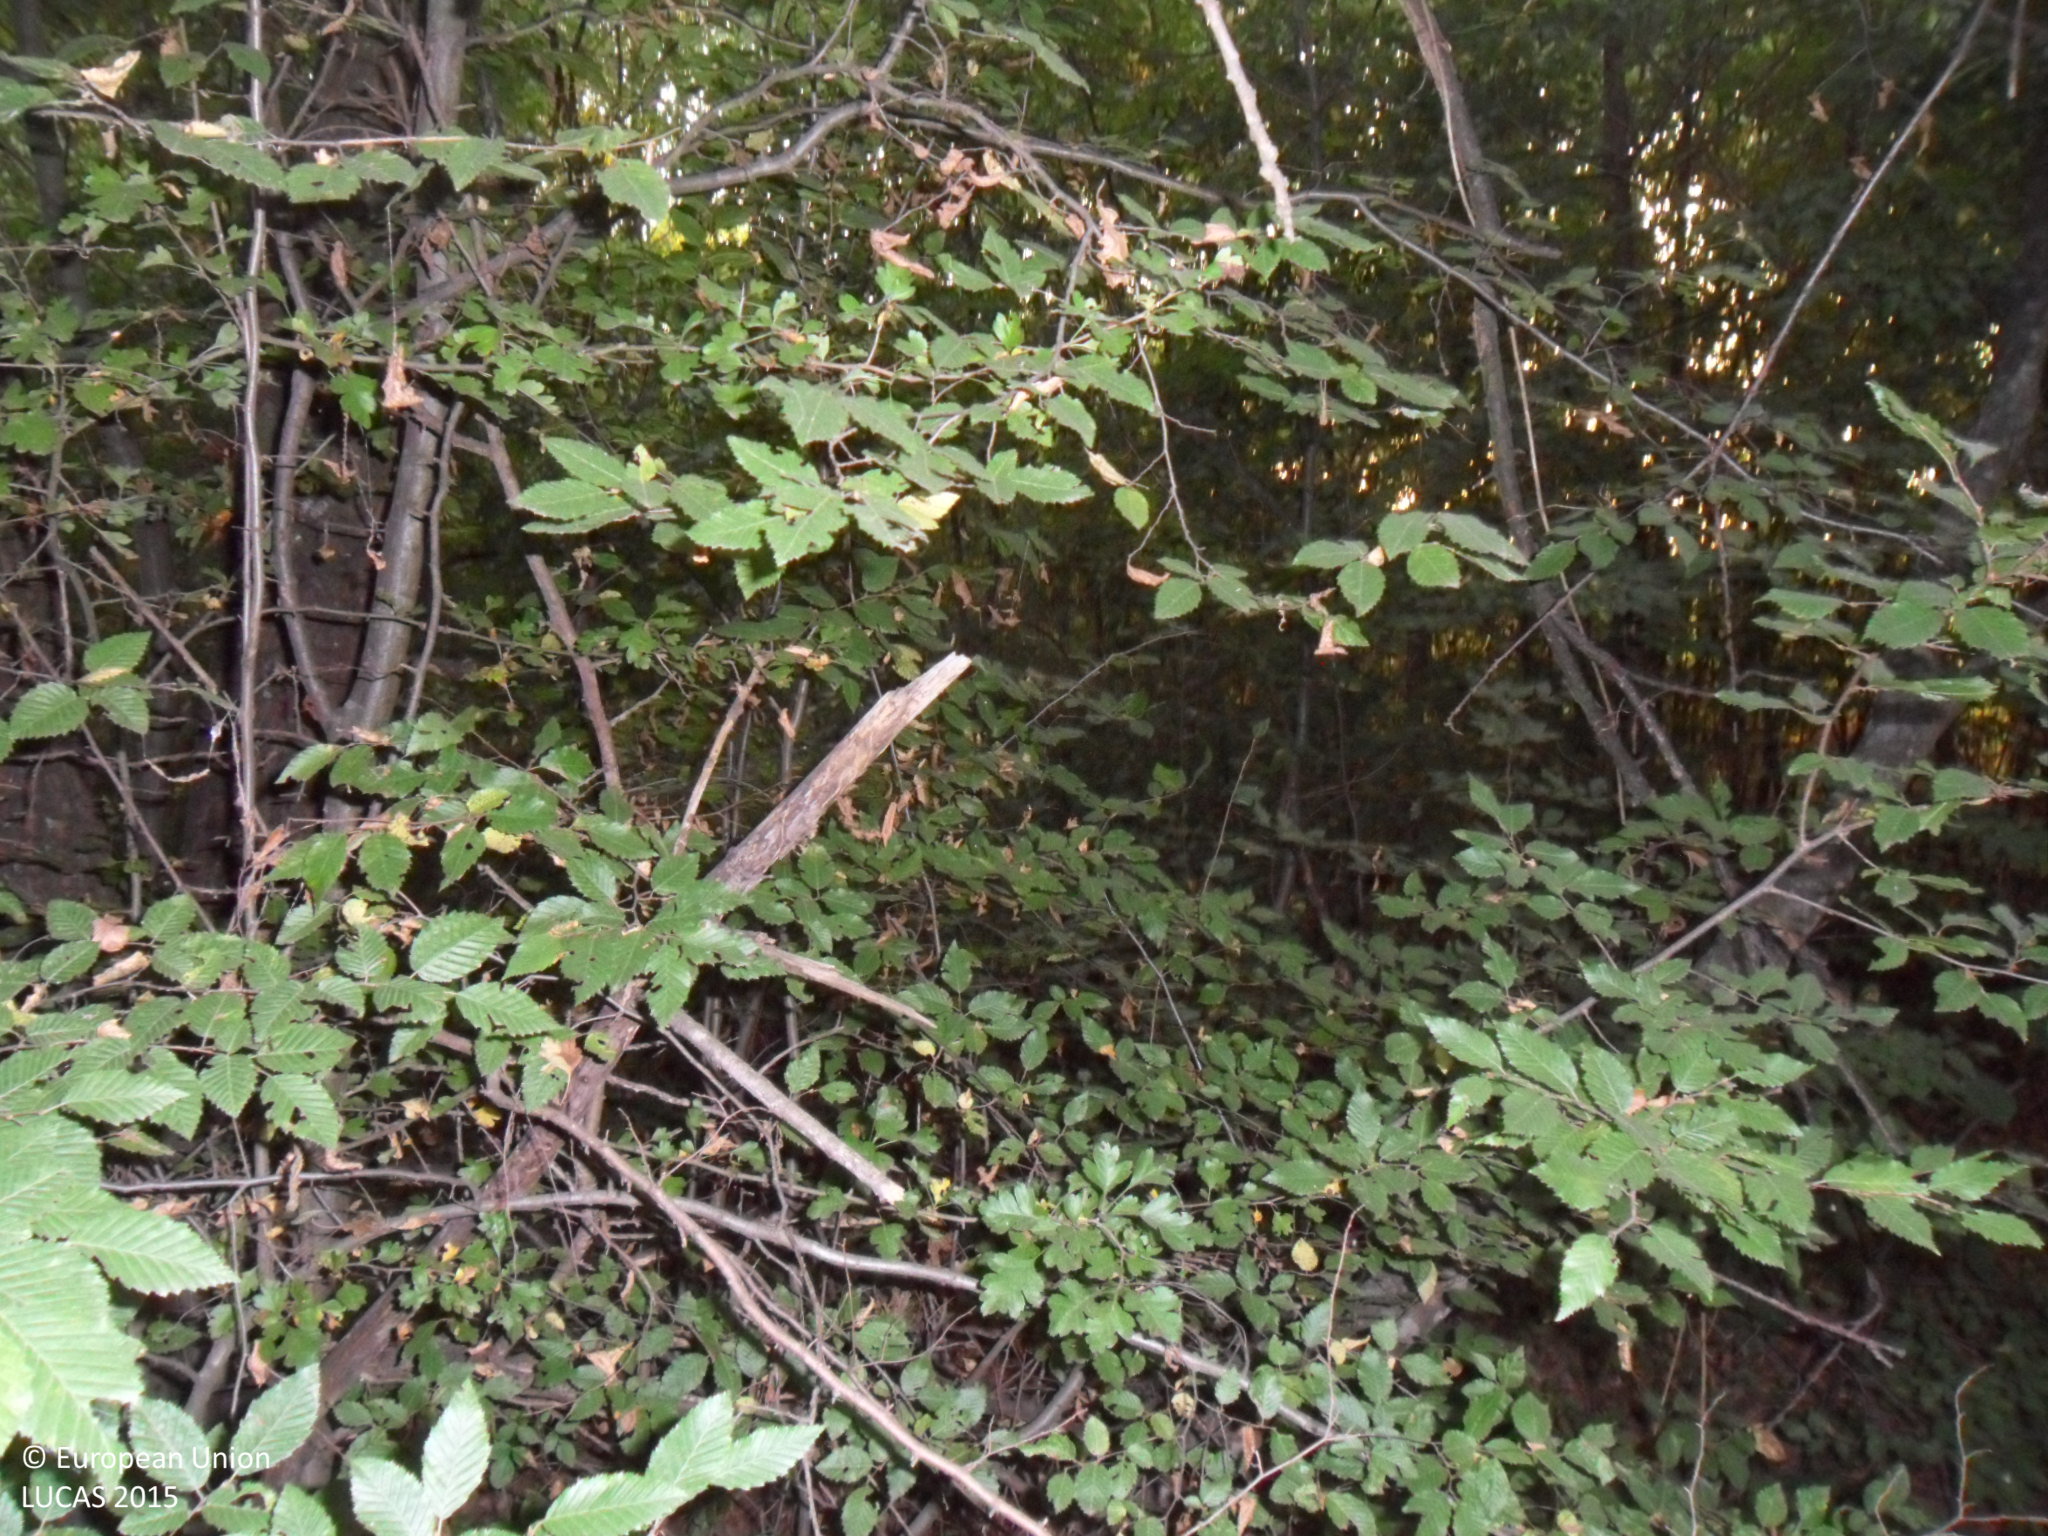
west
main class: Woodland
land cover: Broadleaved woodland
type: mesophytic deciduous forest
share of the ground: > 75 %
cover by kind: broadleaved forest trees 100 %
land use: Forestry
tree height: > 5 m
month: September
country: BG
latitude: 43.6504
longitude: 26.2300
